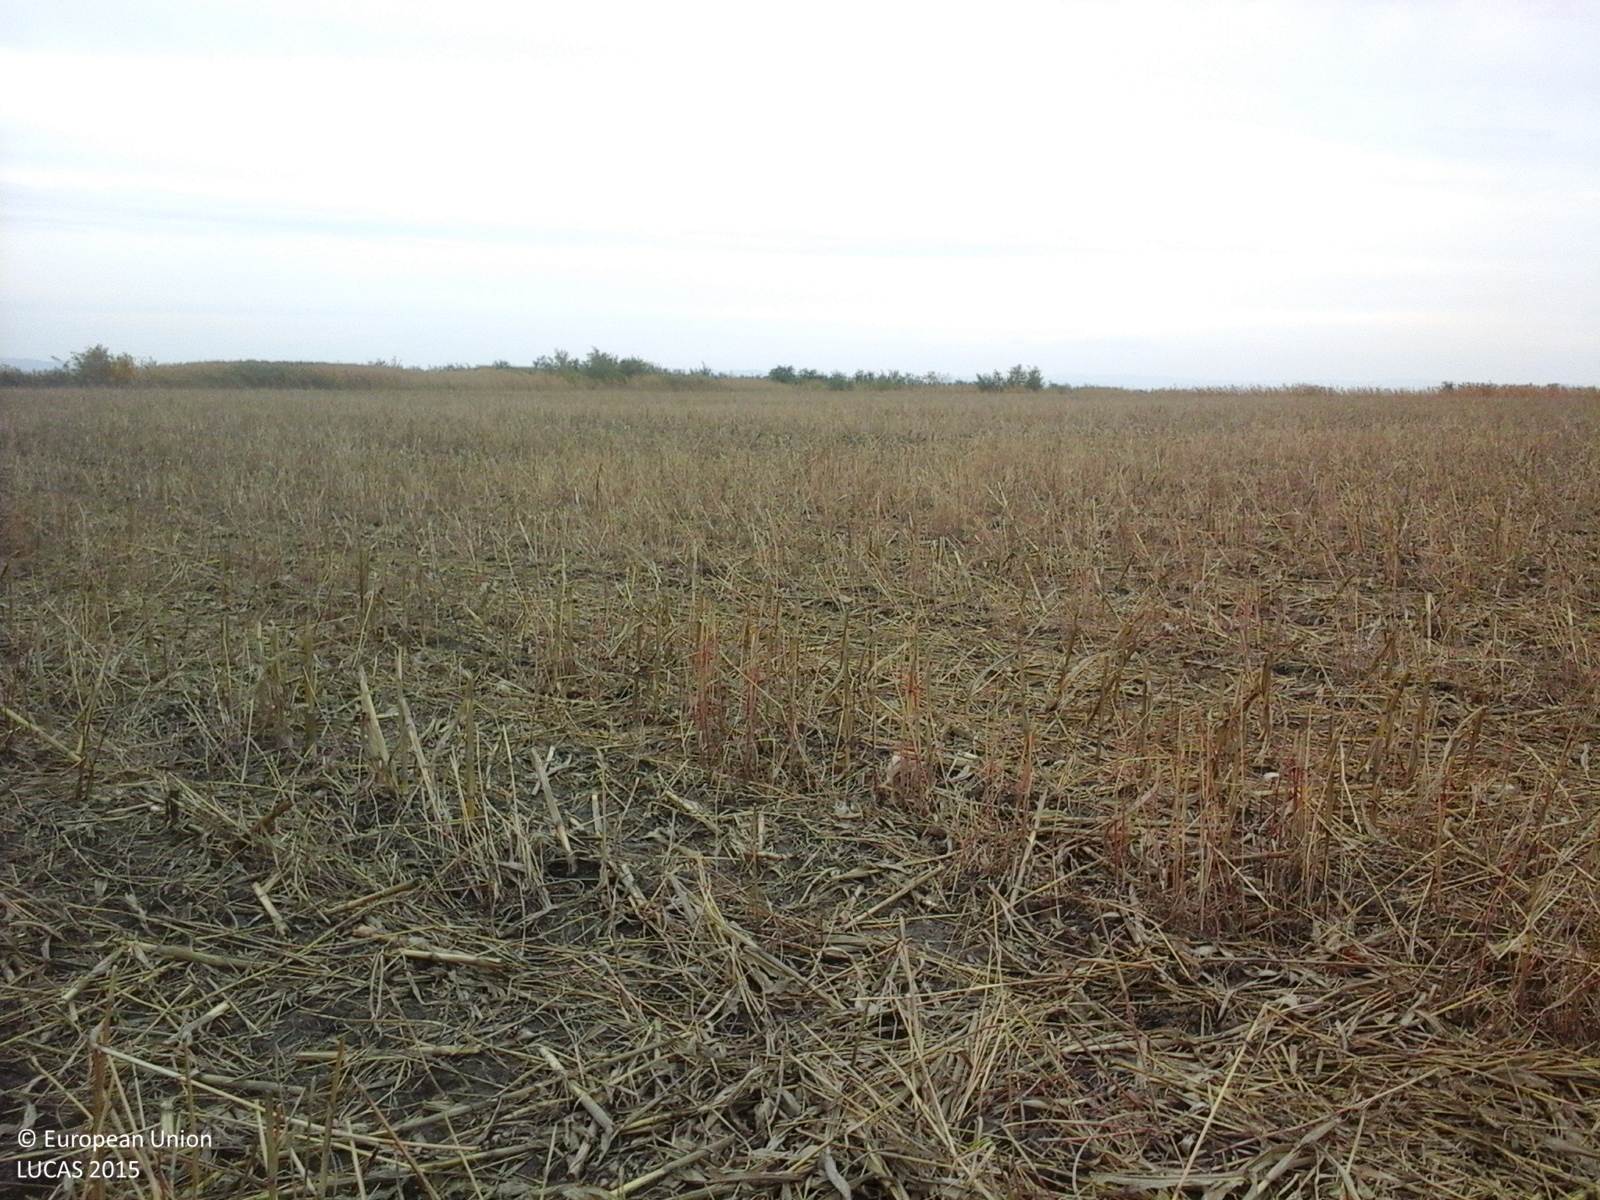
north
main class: Cropland
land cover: Maize
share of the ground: 10 - 25 %
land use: Agriculture (excluding fallow land and kitchen gardens)
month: October
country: RO
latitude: 44.8518
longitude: 26.2977
